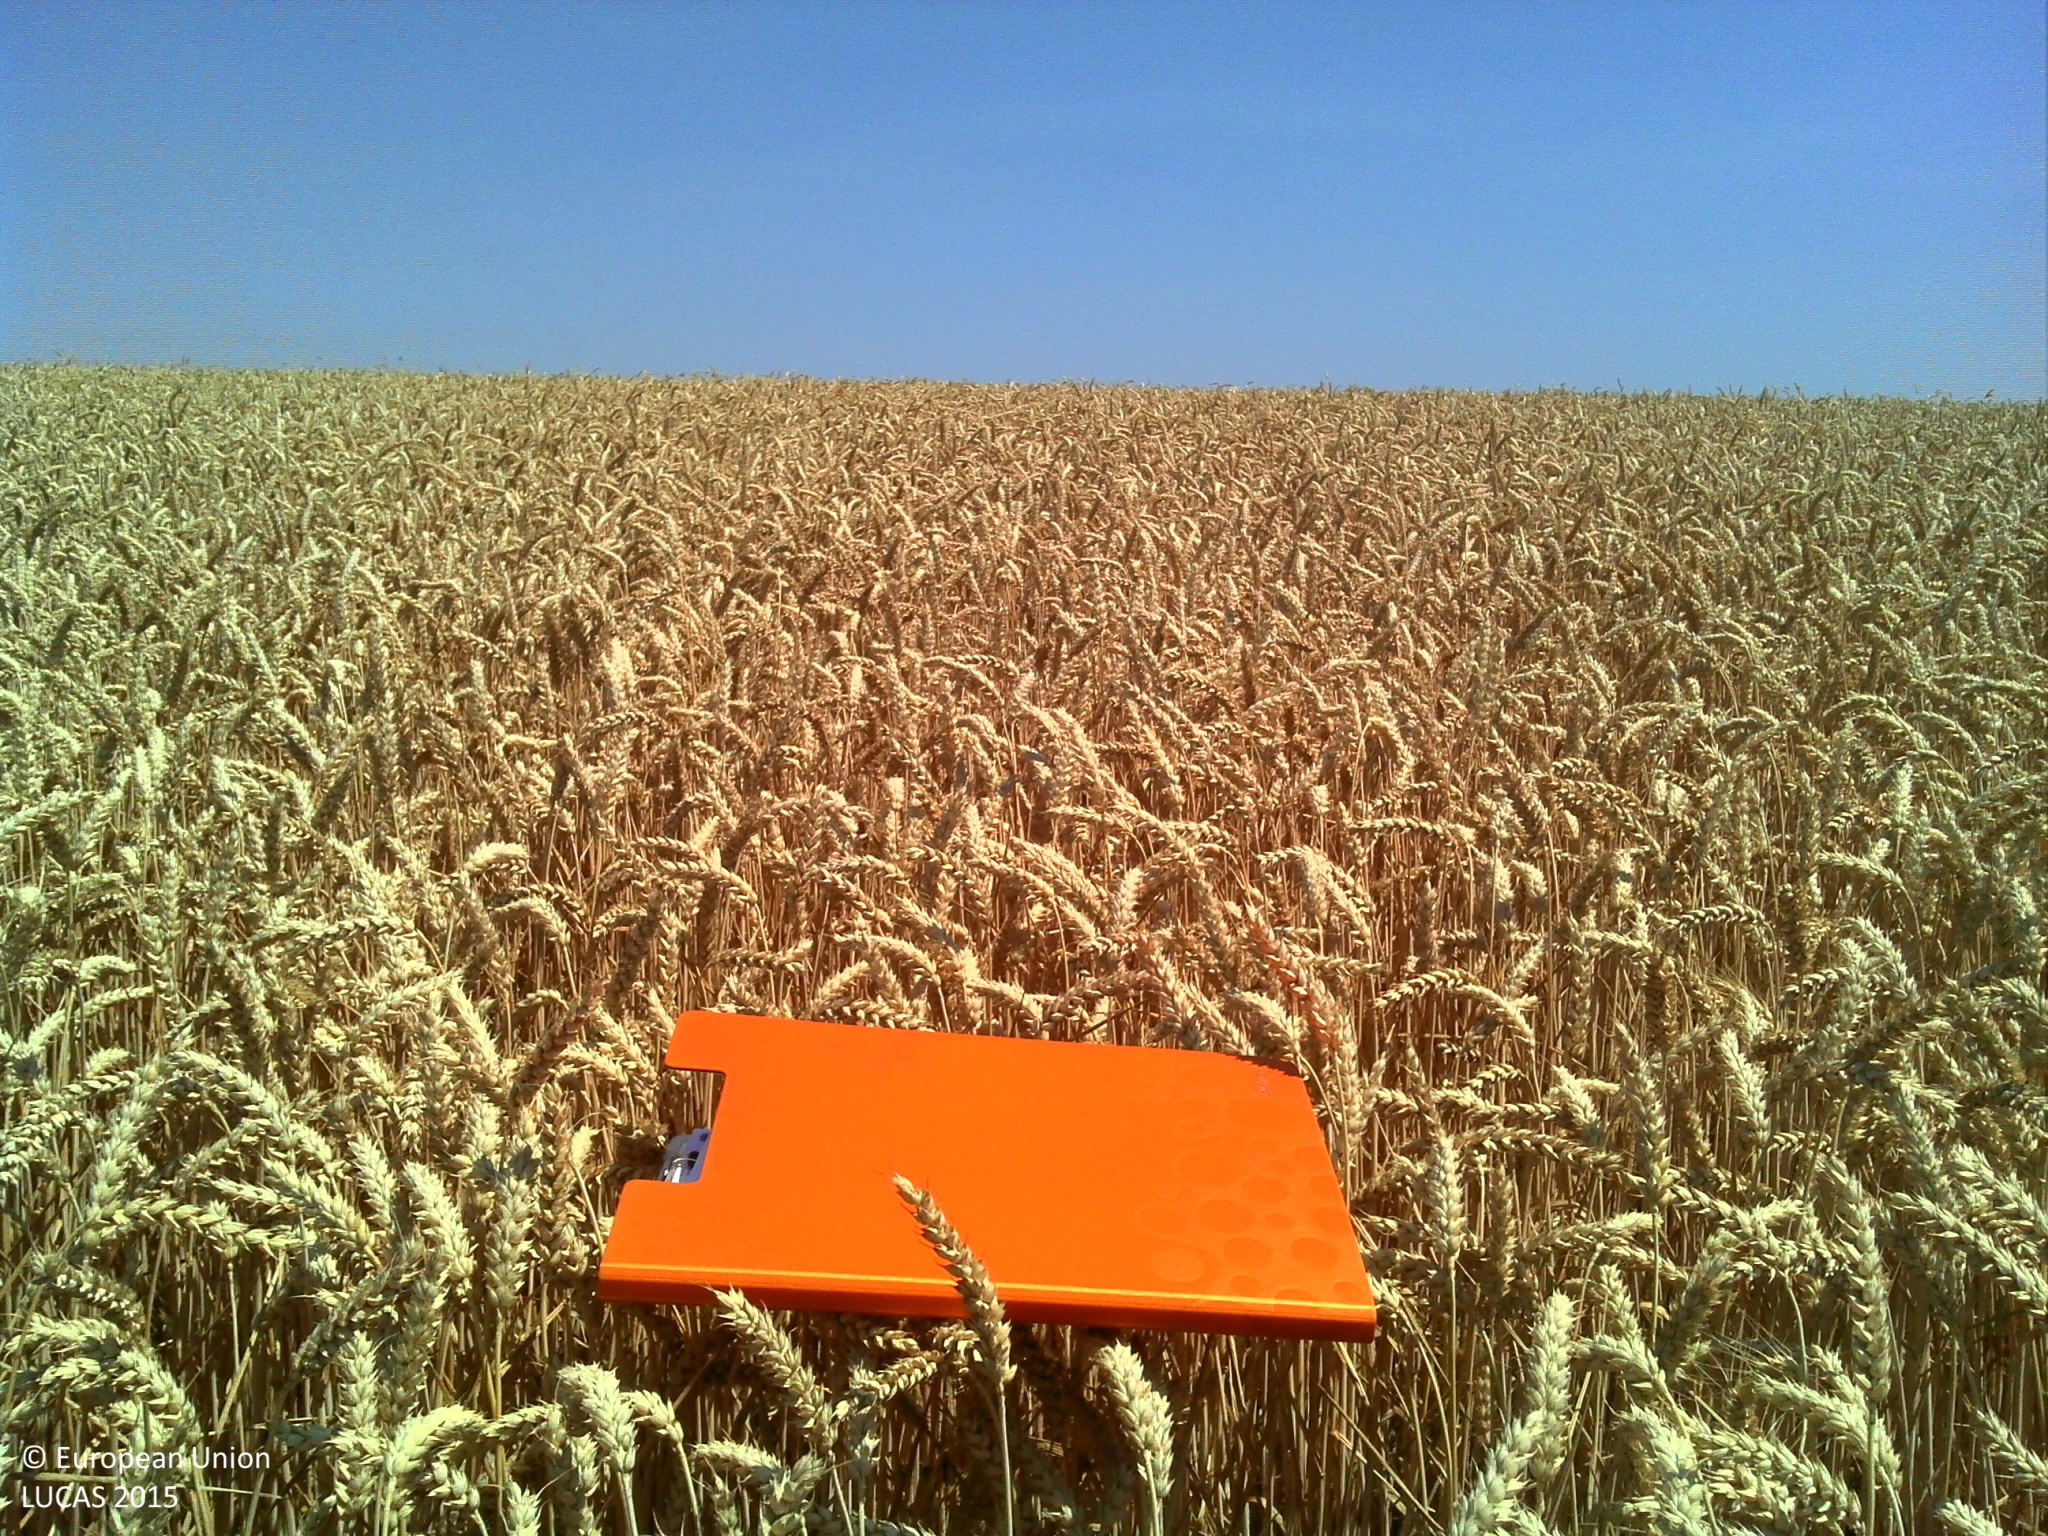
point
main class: Cropland
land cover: Common wheat
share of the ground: > 75 %
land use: Agriculture (excluding fallow land and kitchen gardens)
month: July
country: FR
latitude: 47.0259
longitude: 3.5900
